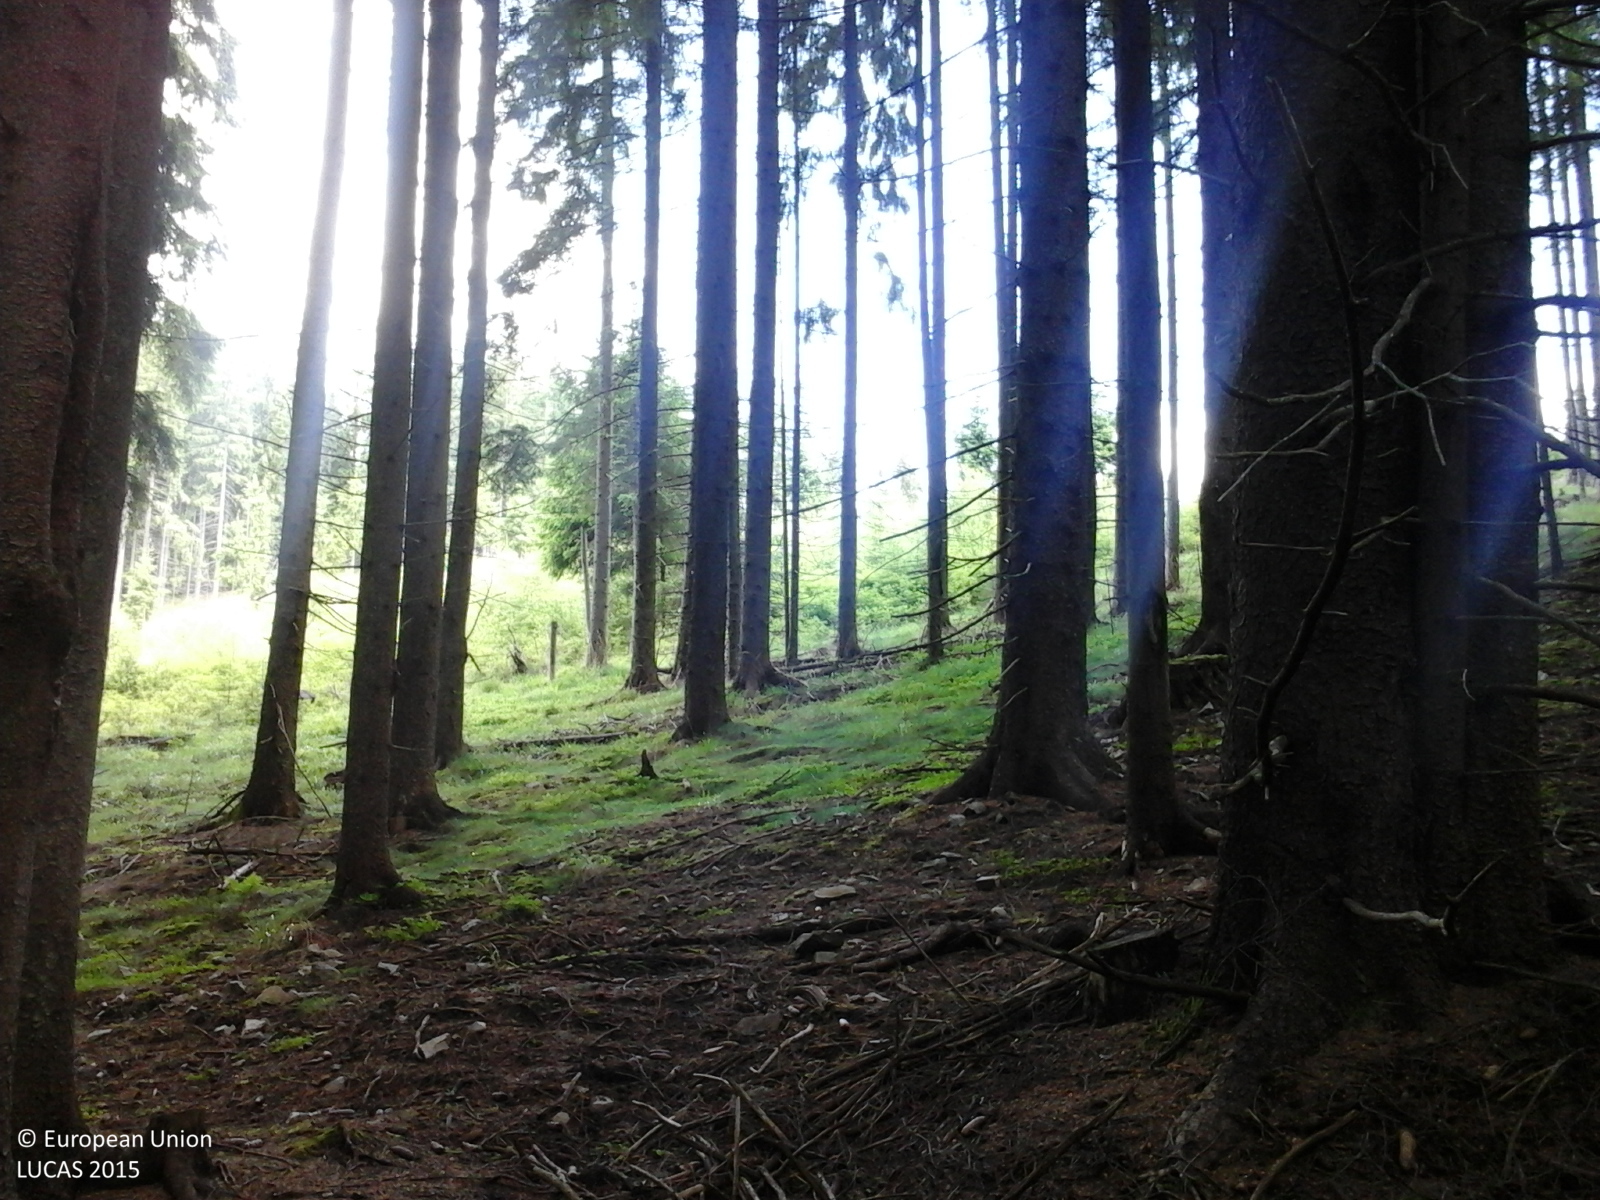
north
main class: Woodland
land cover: Other coniferous woodland
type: alpine coniferous forest
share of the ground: > 75 %
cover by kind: coniferous forest trees 100 %
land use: Forestry
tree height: > 5 m
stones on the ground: 10 - 25 %
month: June
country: RO
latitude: 47.7582
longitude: 25.2535
